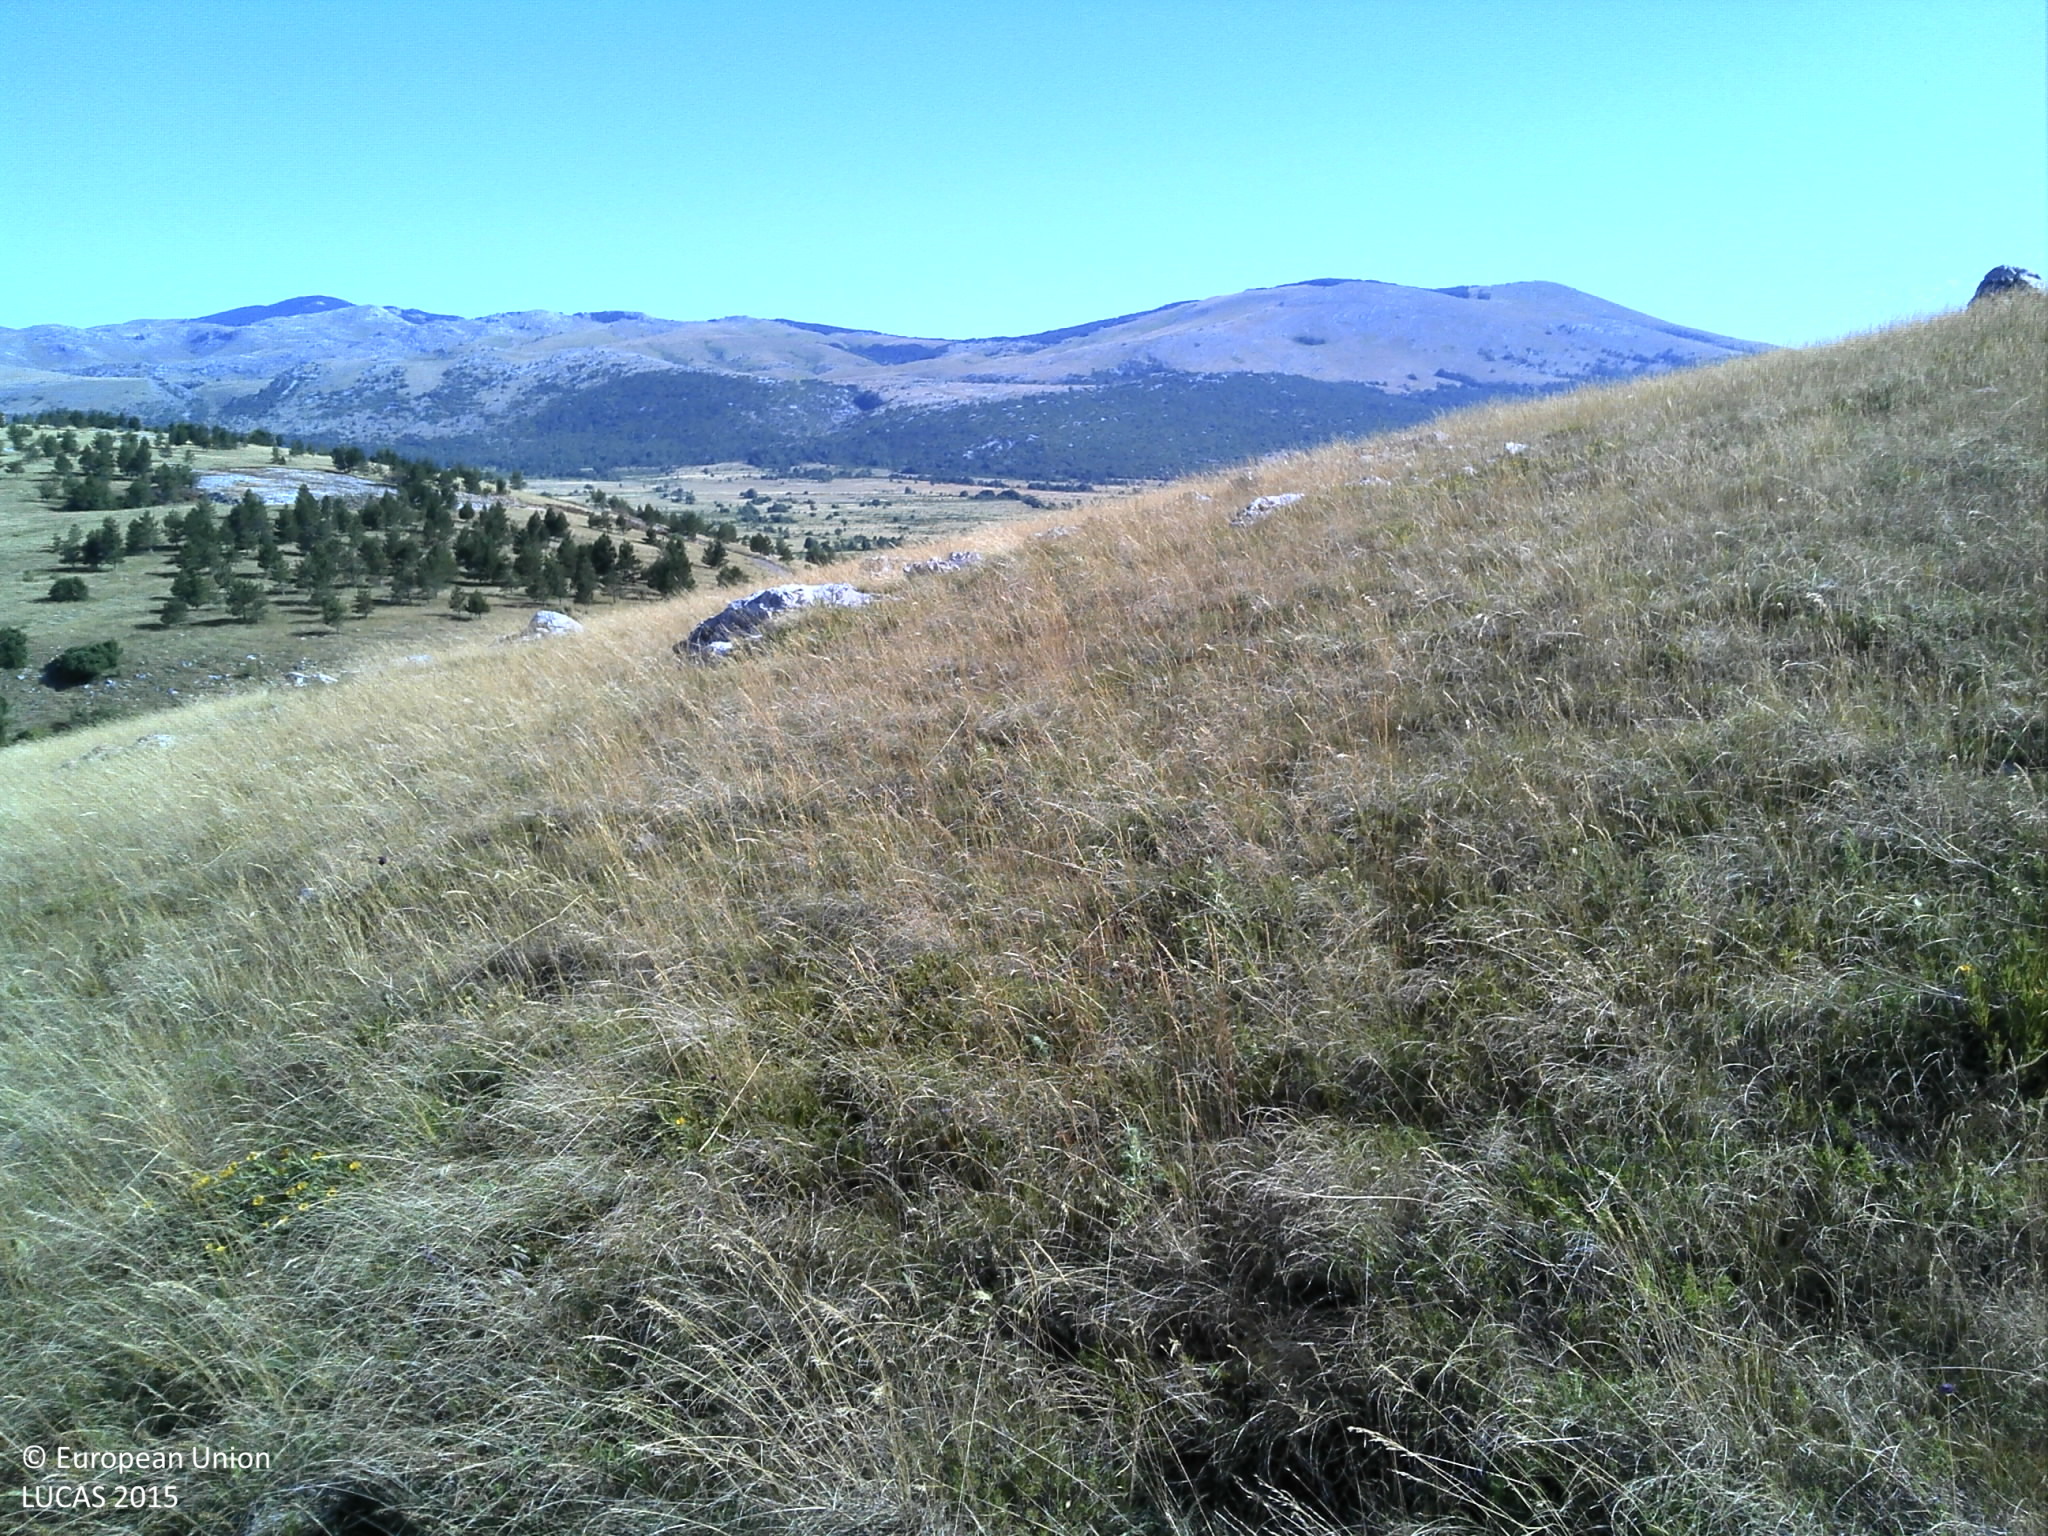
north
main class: Grassland
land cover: Grassland with sparse tree/shrub cover
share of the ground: > 75 %
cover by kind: herbaceous plants 80 %, broadleaved forest trees 5 %, shrubs 5 %, consolidated bare surface 5 %, unconsolidated bare surface 5 %
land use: Semi-natural and natural areas not in use
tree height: < 5 m
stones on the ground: 10 - 25 %
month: July
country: HR
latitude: 44.2648
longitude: 16.0435
